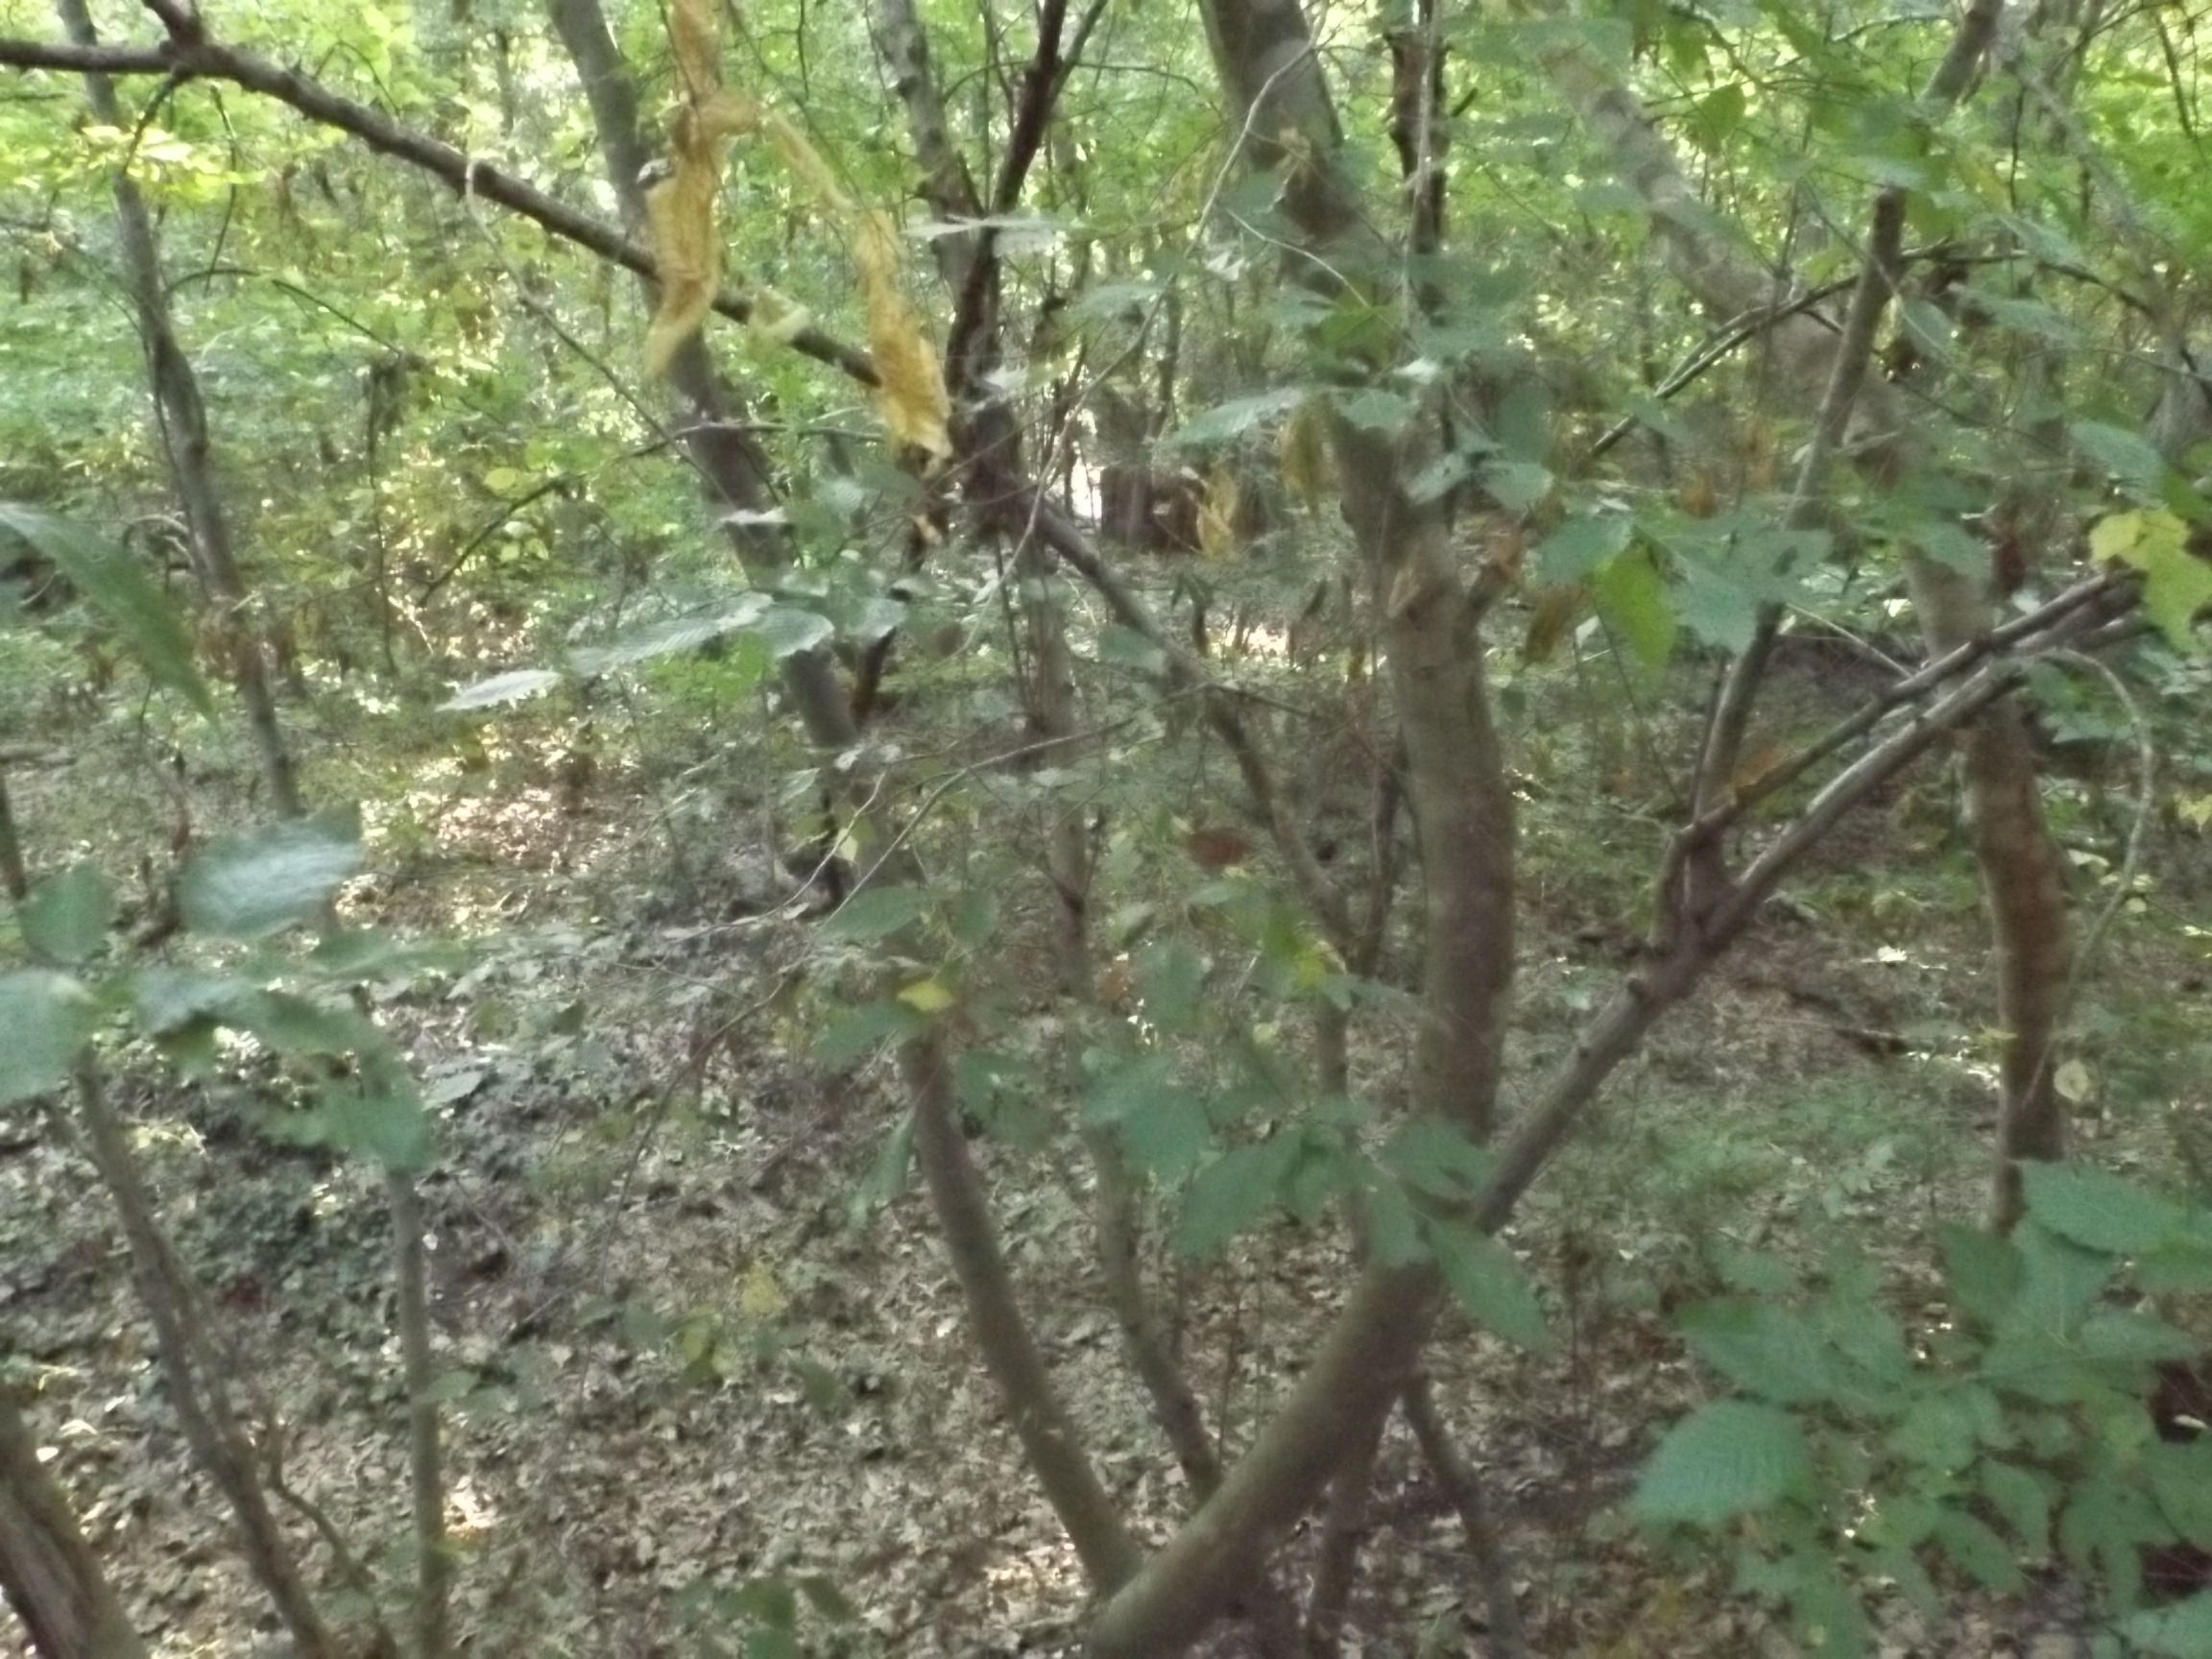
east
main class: Woodland
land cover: Broadleaved woodland
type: mesophytic deciduous forest
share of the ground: > 75 %
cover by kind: broadleaved forest trees 100 %
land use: Forestry
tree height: > 5 m
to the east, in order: Broadleaved woodland
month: August
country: BG
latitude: 43.3255
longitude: 28.0382
